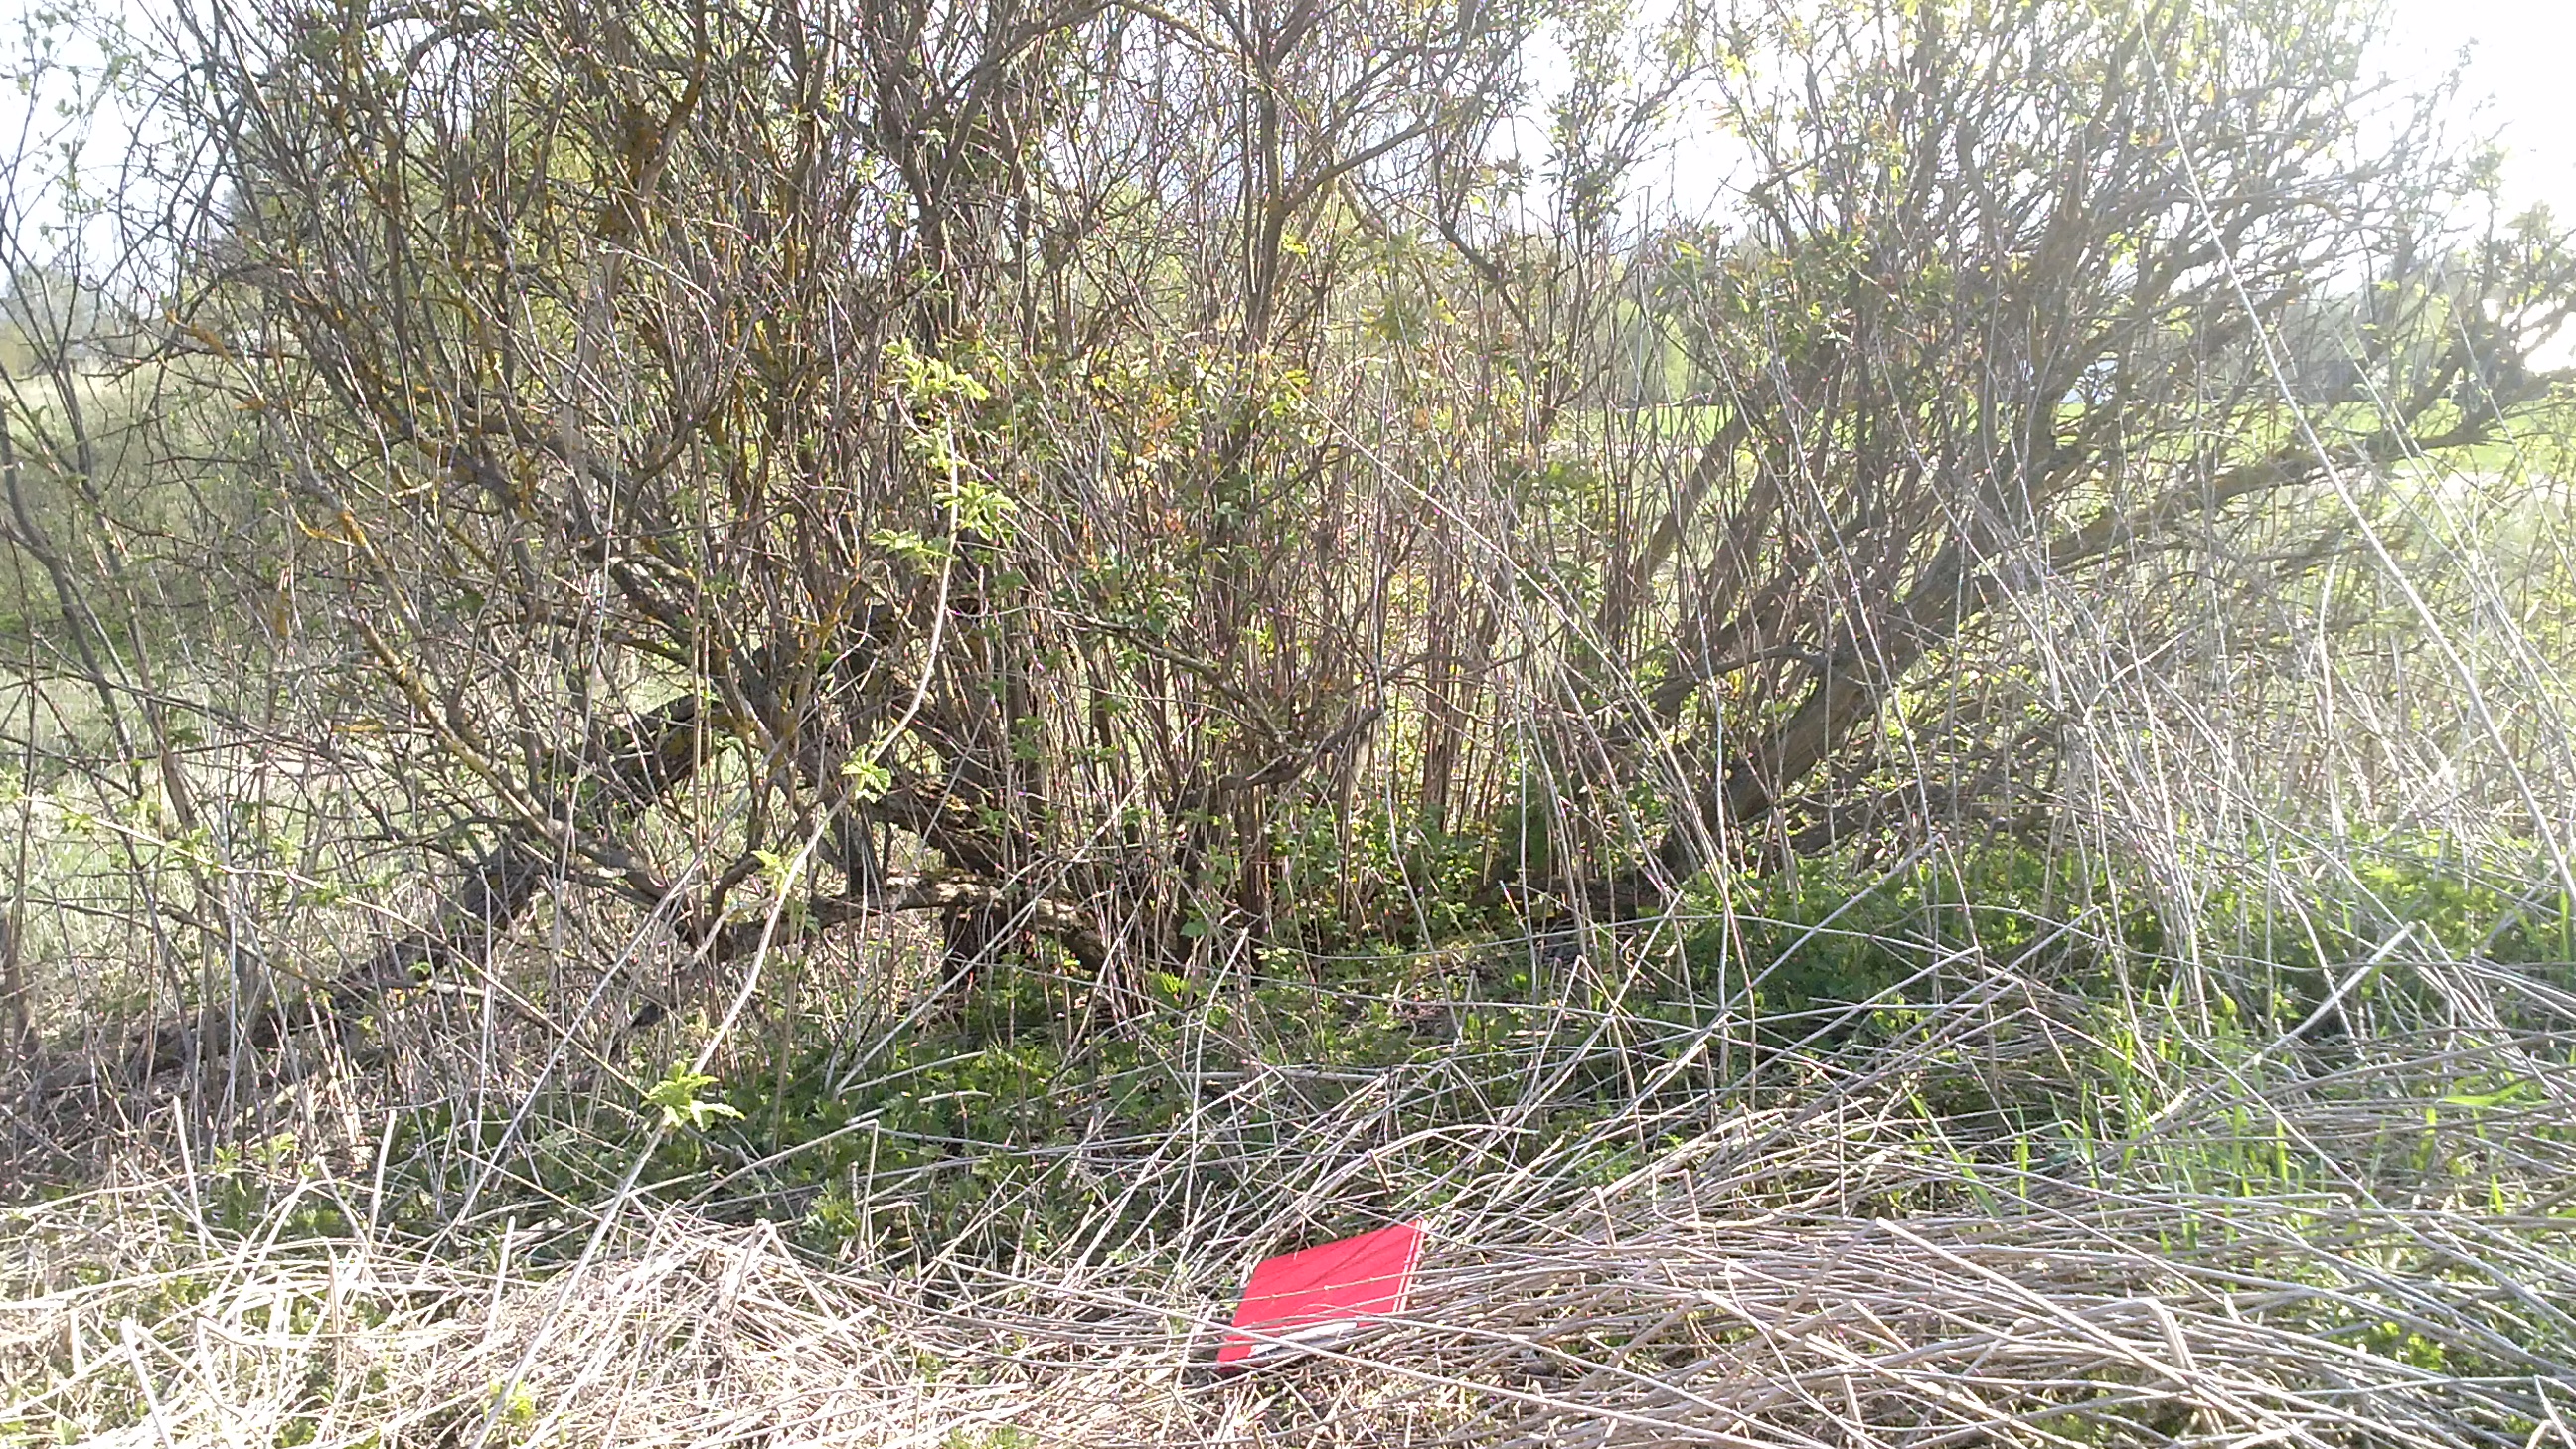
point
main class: Woodland
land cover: Broadleaved woodland
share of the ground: 10 - 25 %
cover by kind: herbaceous plants 80 %, broadleaved forest trees 20 %
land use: Semi-natural and natural areas not in use
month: May
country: LV
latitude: 55.9142
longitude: 27.0795
